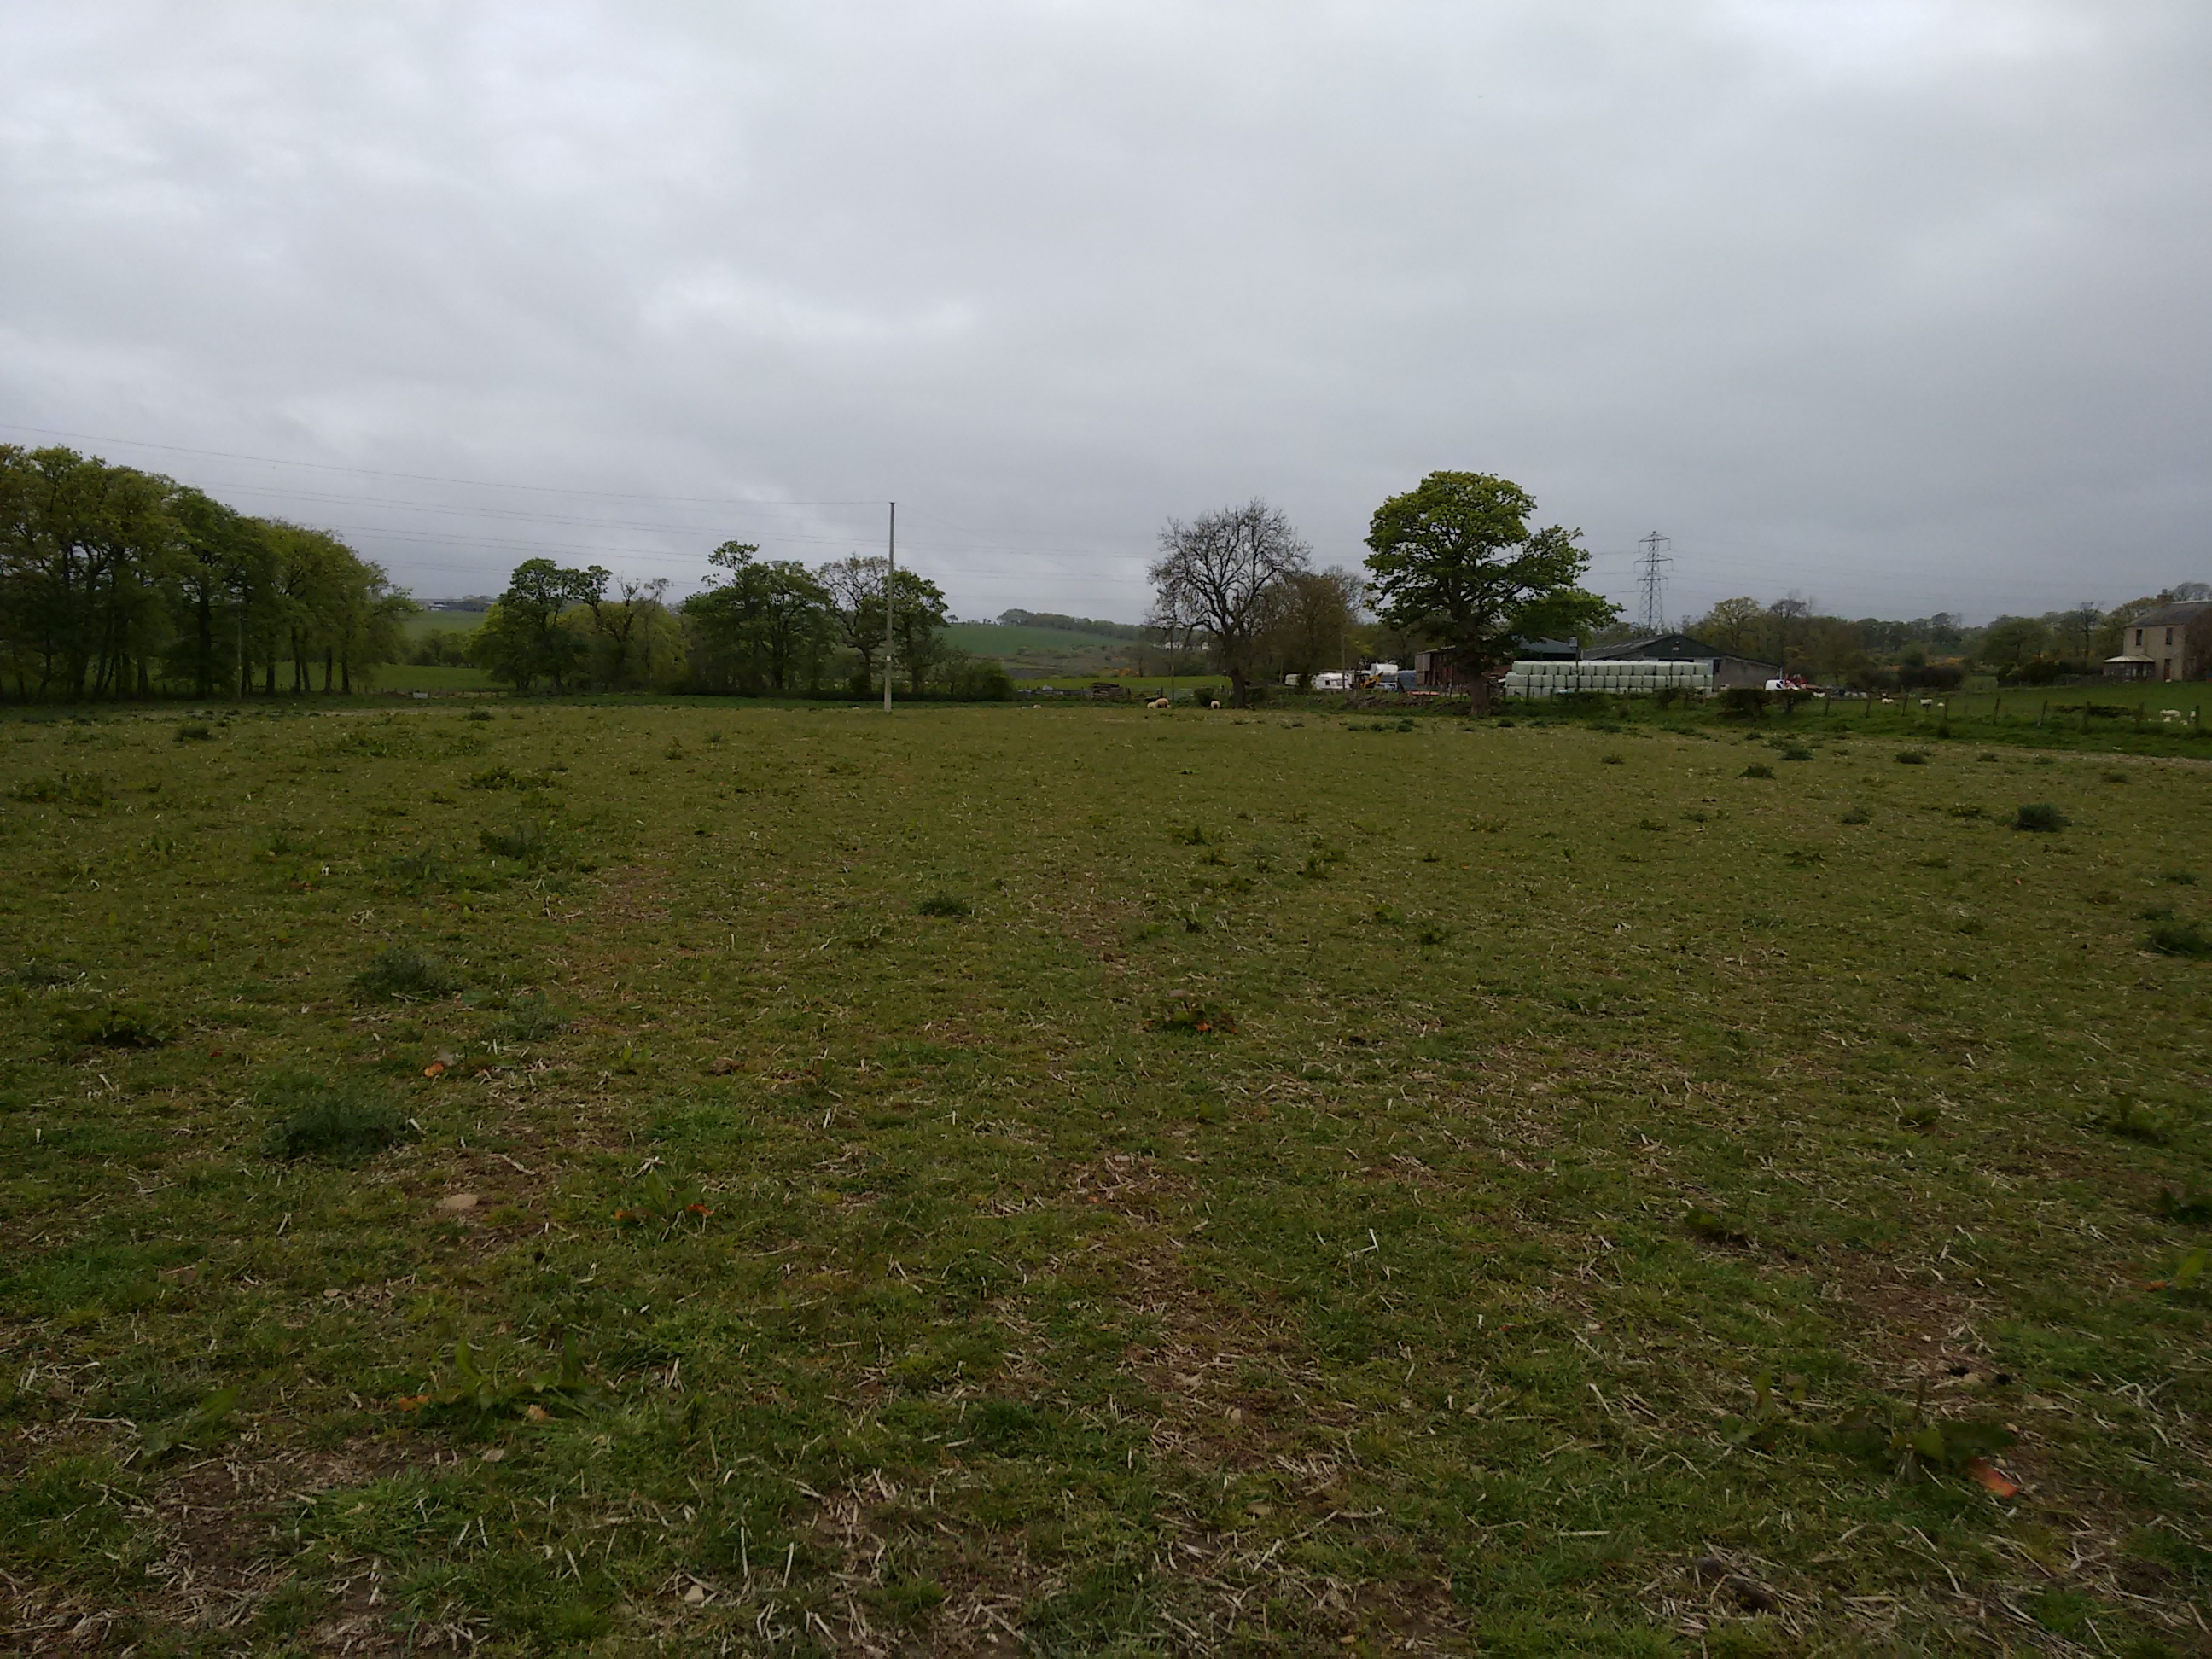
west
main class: Grassland
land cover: Grassland without tree/shrub cover
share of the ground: > 75 %
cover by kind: herbaceous plants 95 %, unconsolidated bare surface 5 %
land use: Agriculture (excluding fallow land and kitchen gardens)
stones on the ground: < 10 %
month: May
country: GB
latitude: 55.9232
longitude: -3.6999
